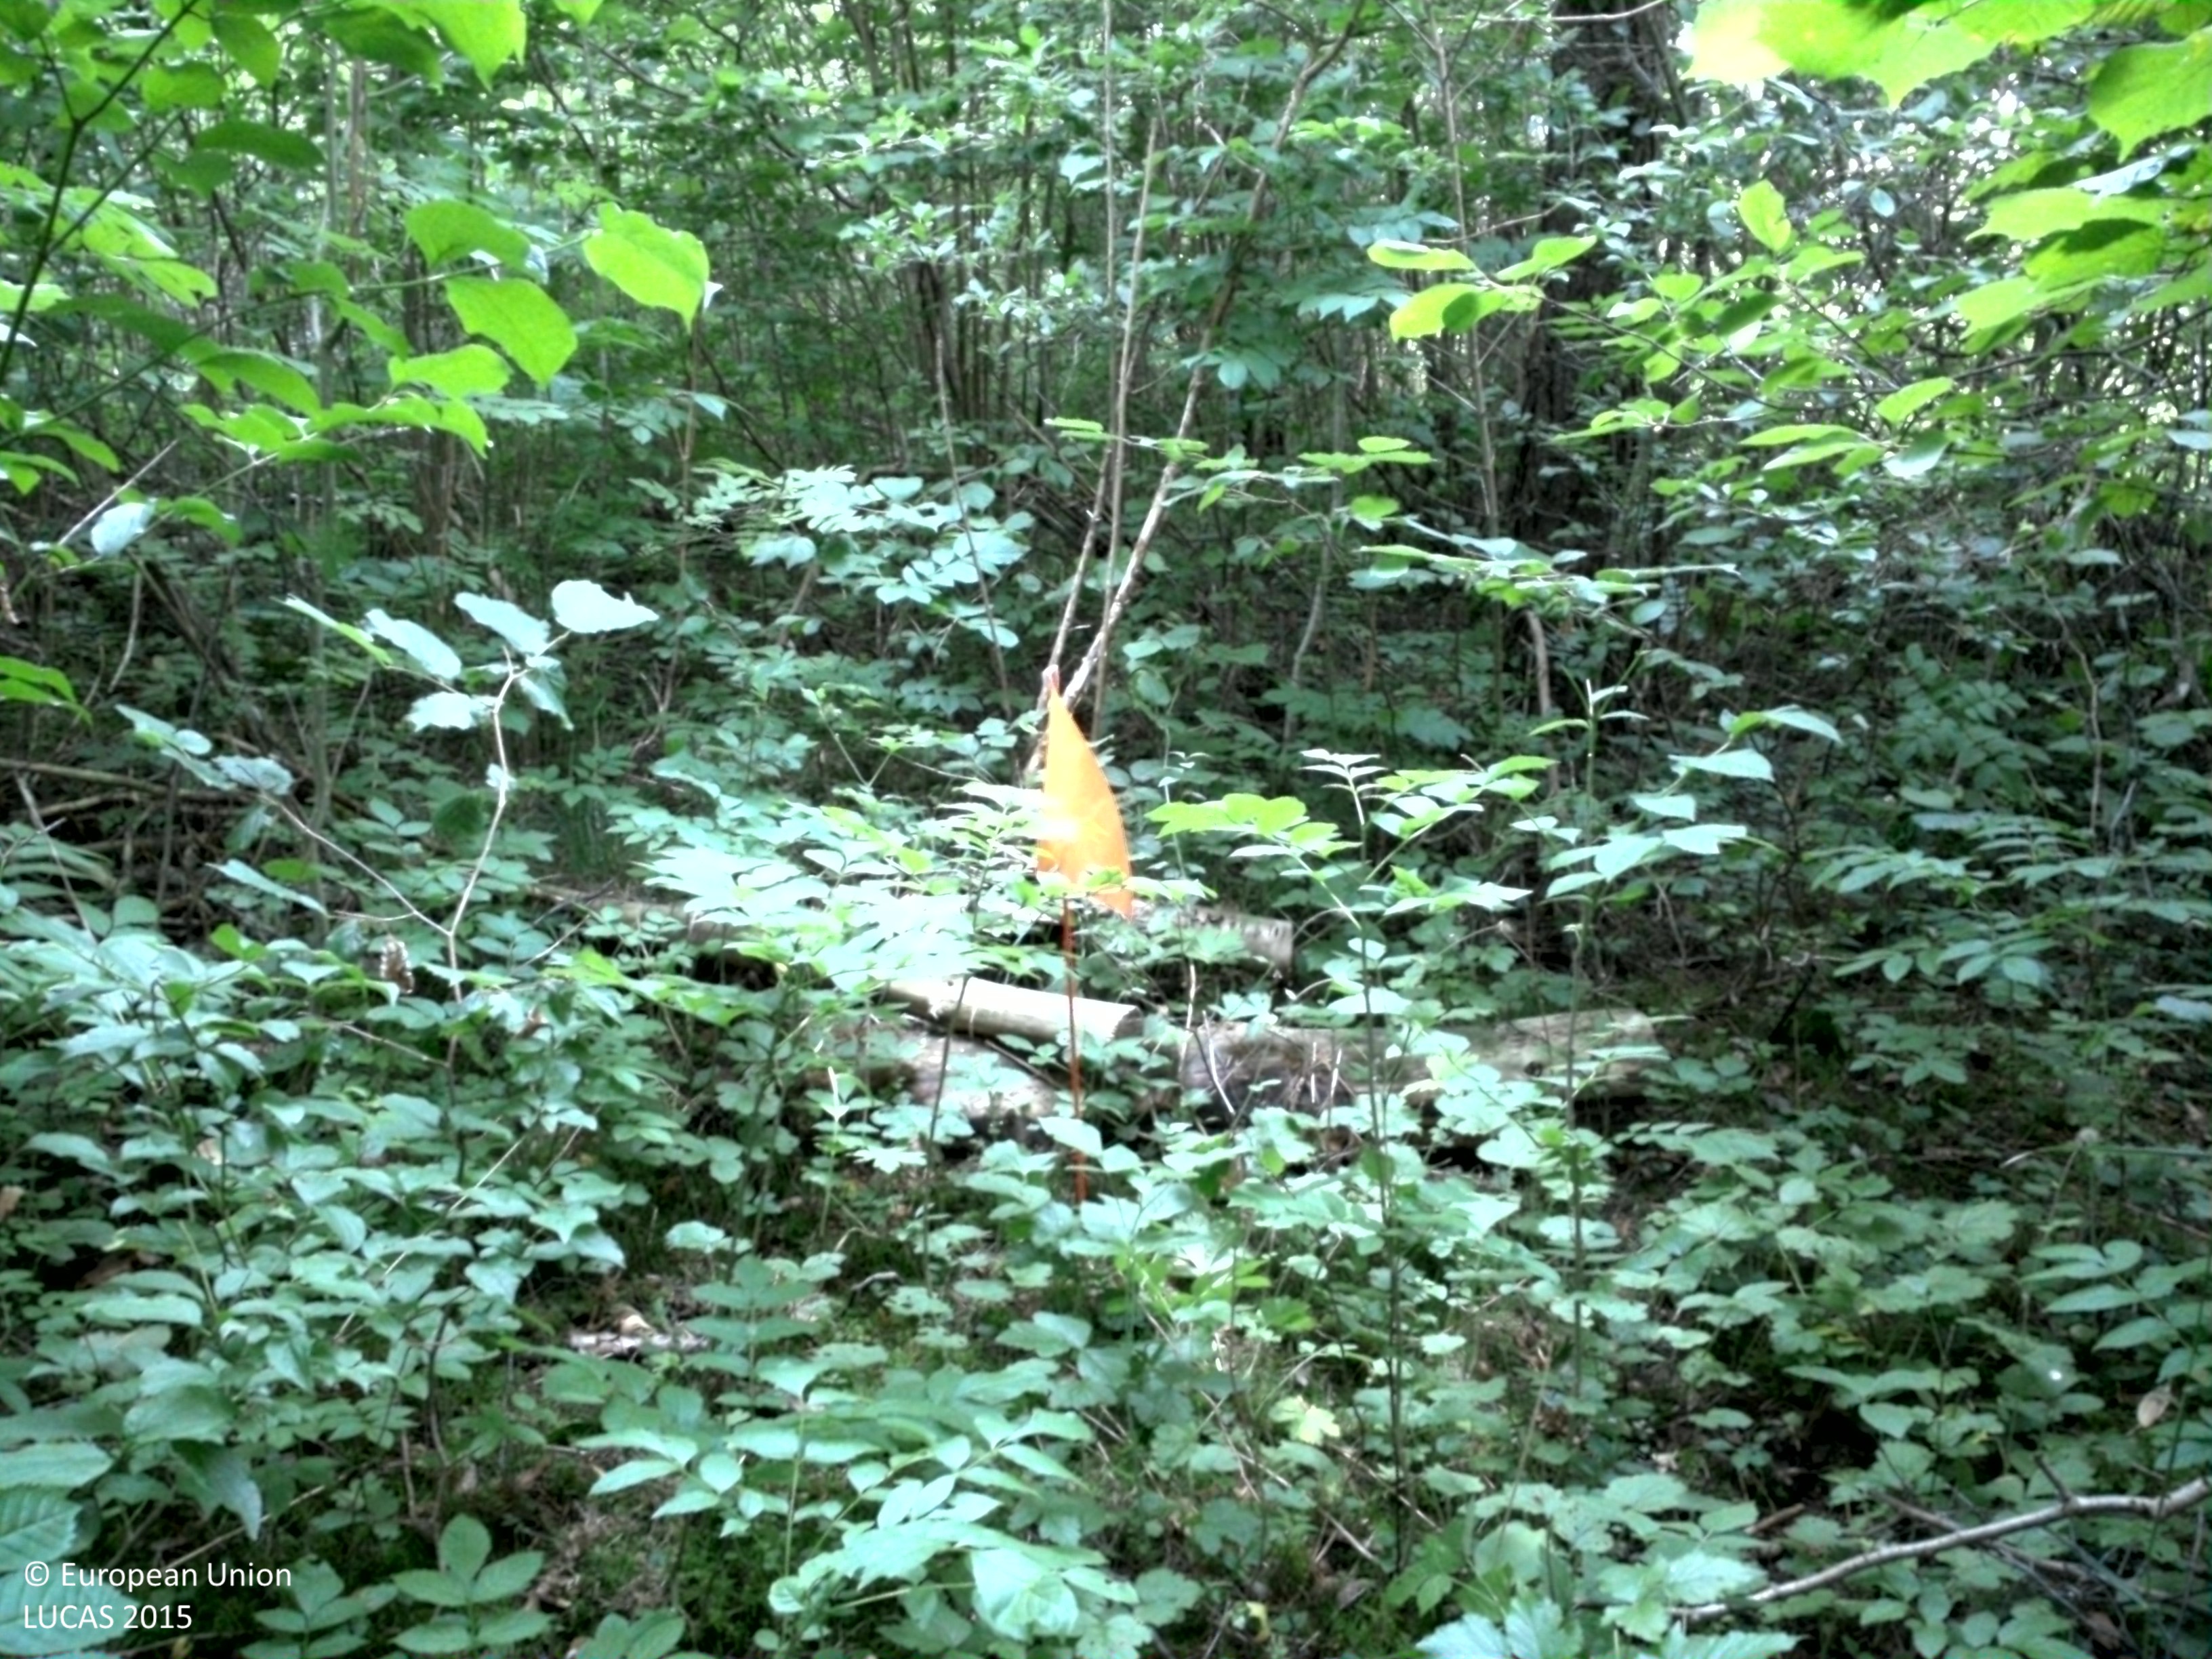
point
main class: Woodland
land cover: Broadleaved woodland
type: mesophytic deciduous forest
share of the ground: > 75 %
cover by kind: broadleaved forest trees 60 %, shrubs 15 %, herbaceous plants 15 %, coniferous forest trees 10 %
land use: Forestry
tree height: > 5 m
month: July
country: SE
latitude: 57.3495
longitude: 18.2673
